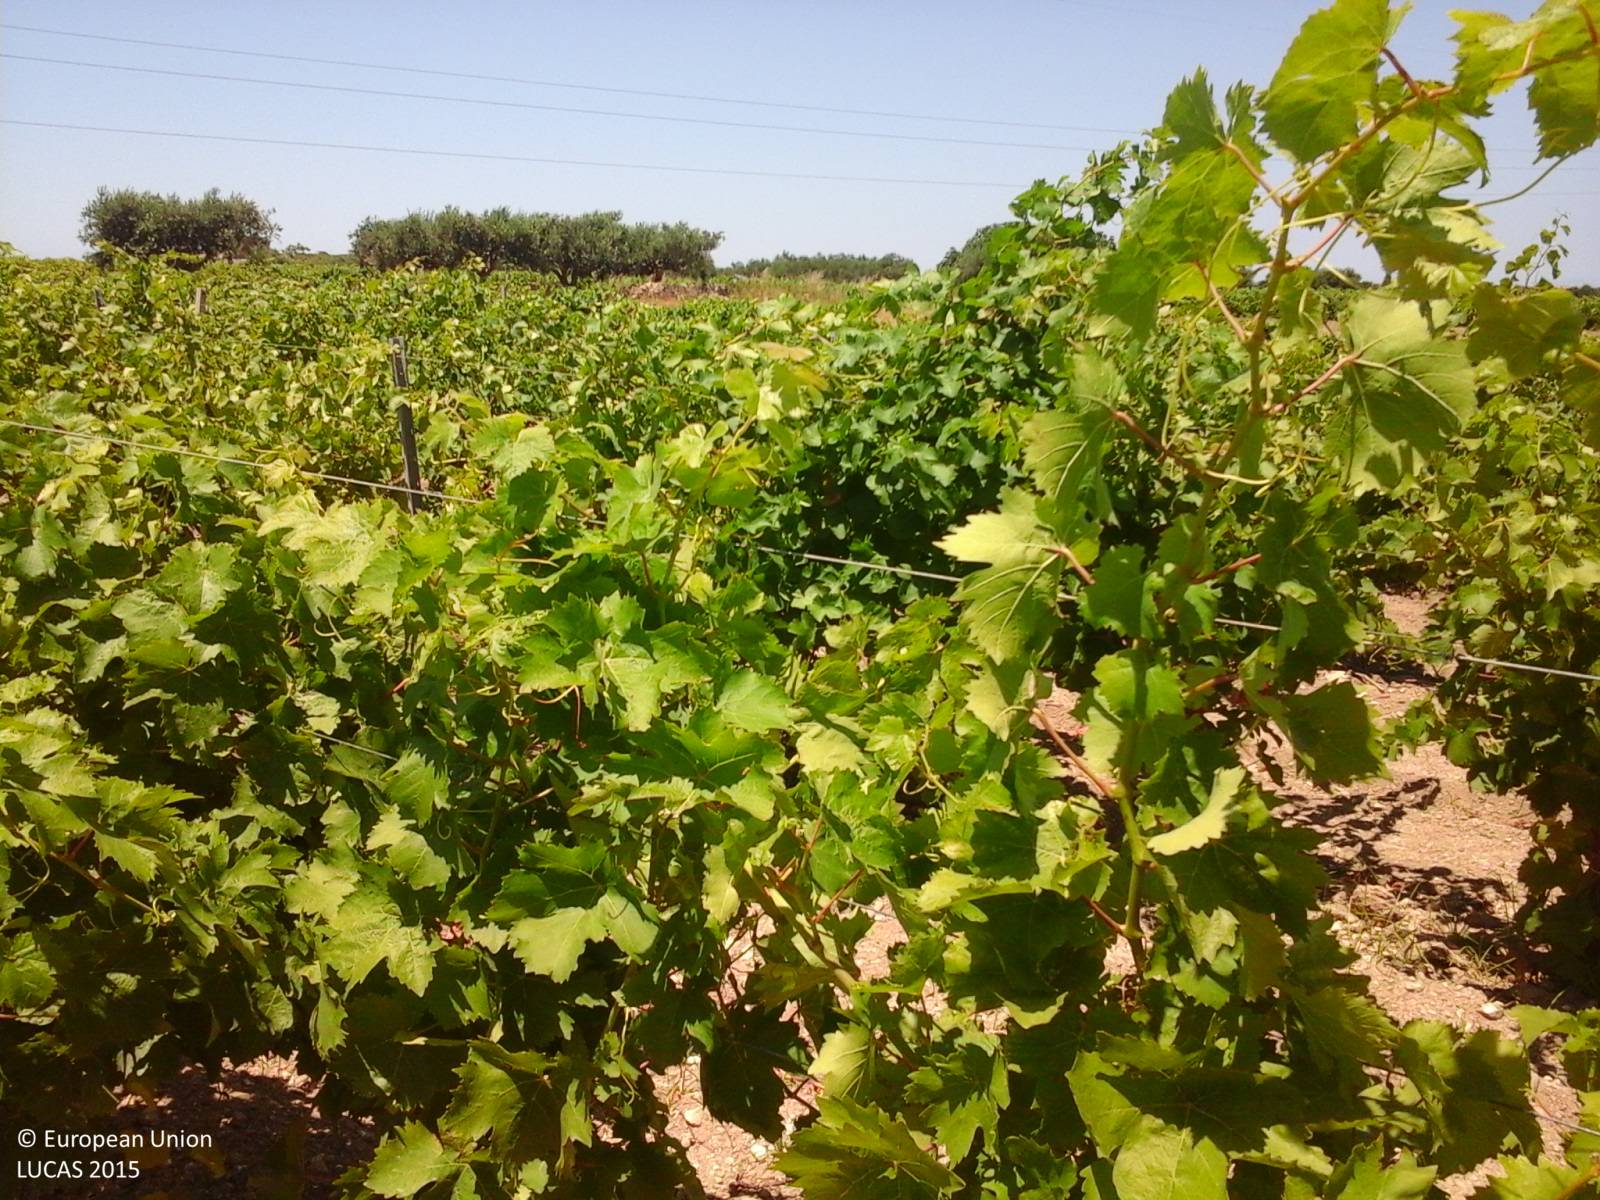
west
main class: Cropland
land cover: Vineyards
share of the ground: 50 - 75 %
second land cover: Other bare soil
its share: > 75 %
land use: Agriculture (excluding fallow land and kitchen gardens)
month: July
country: IT
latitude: 37.7670
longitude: 12.5803
